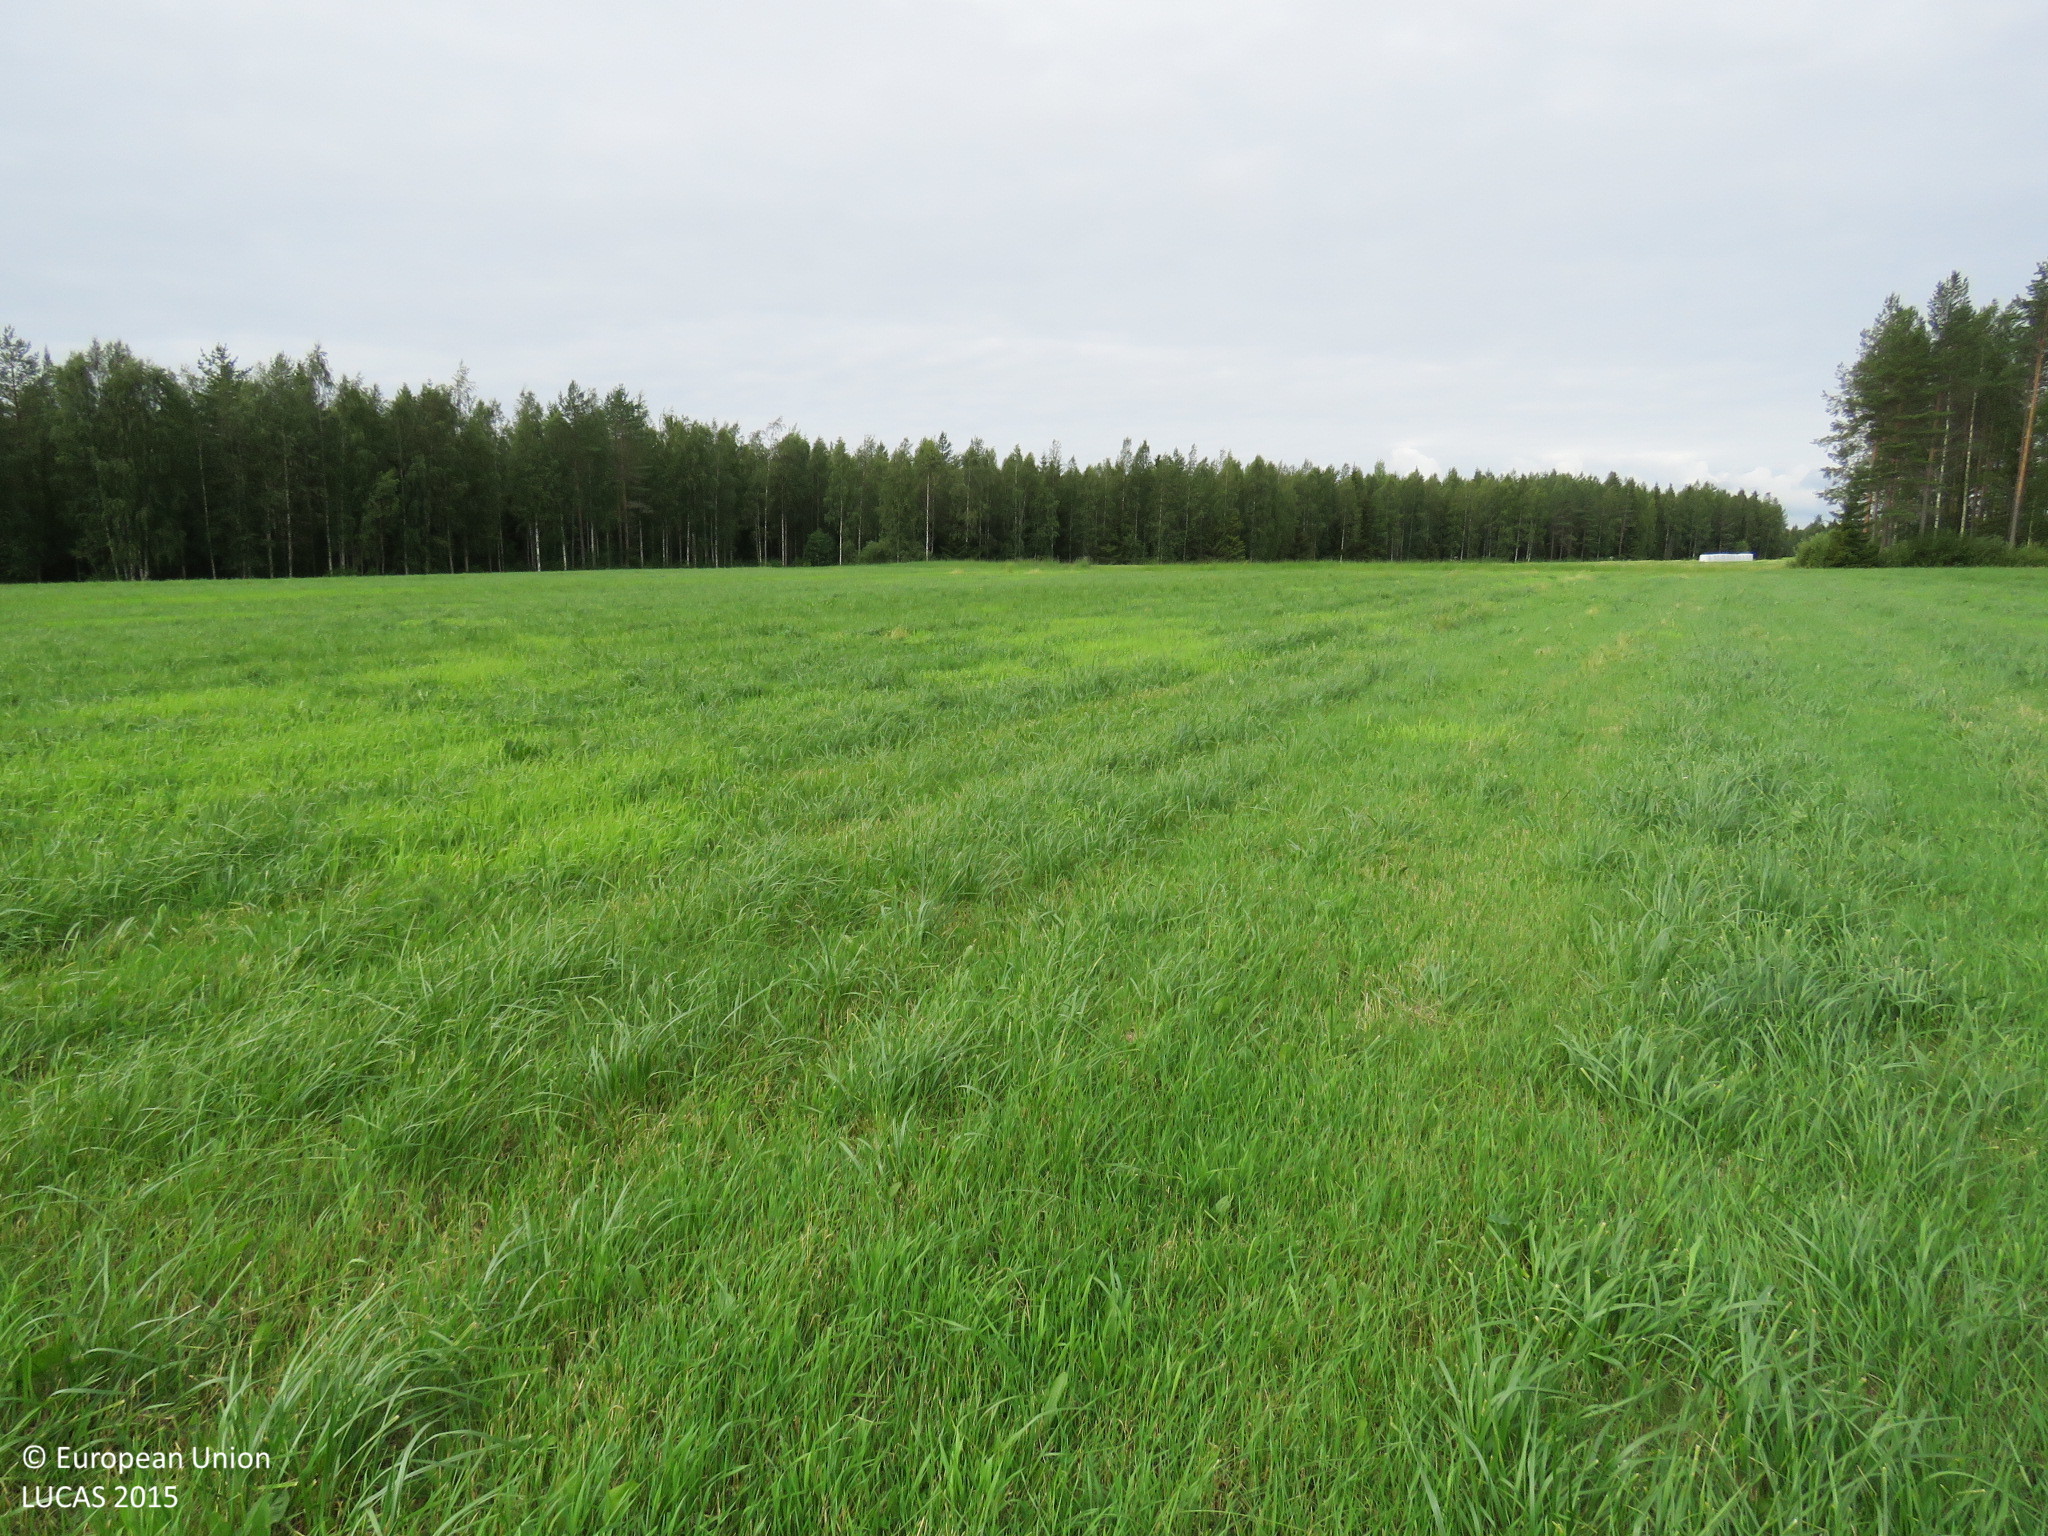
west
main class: Cropland
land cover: Temporary grasslands
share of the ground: > 75 %
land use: Agriculture (excluding fallow land and kitchen gardens)
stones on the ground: < 10 %
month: July
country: FI
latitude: 64.6085
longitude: 26.7791
